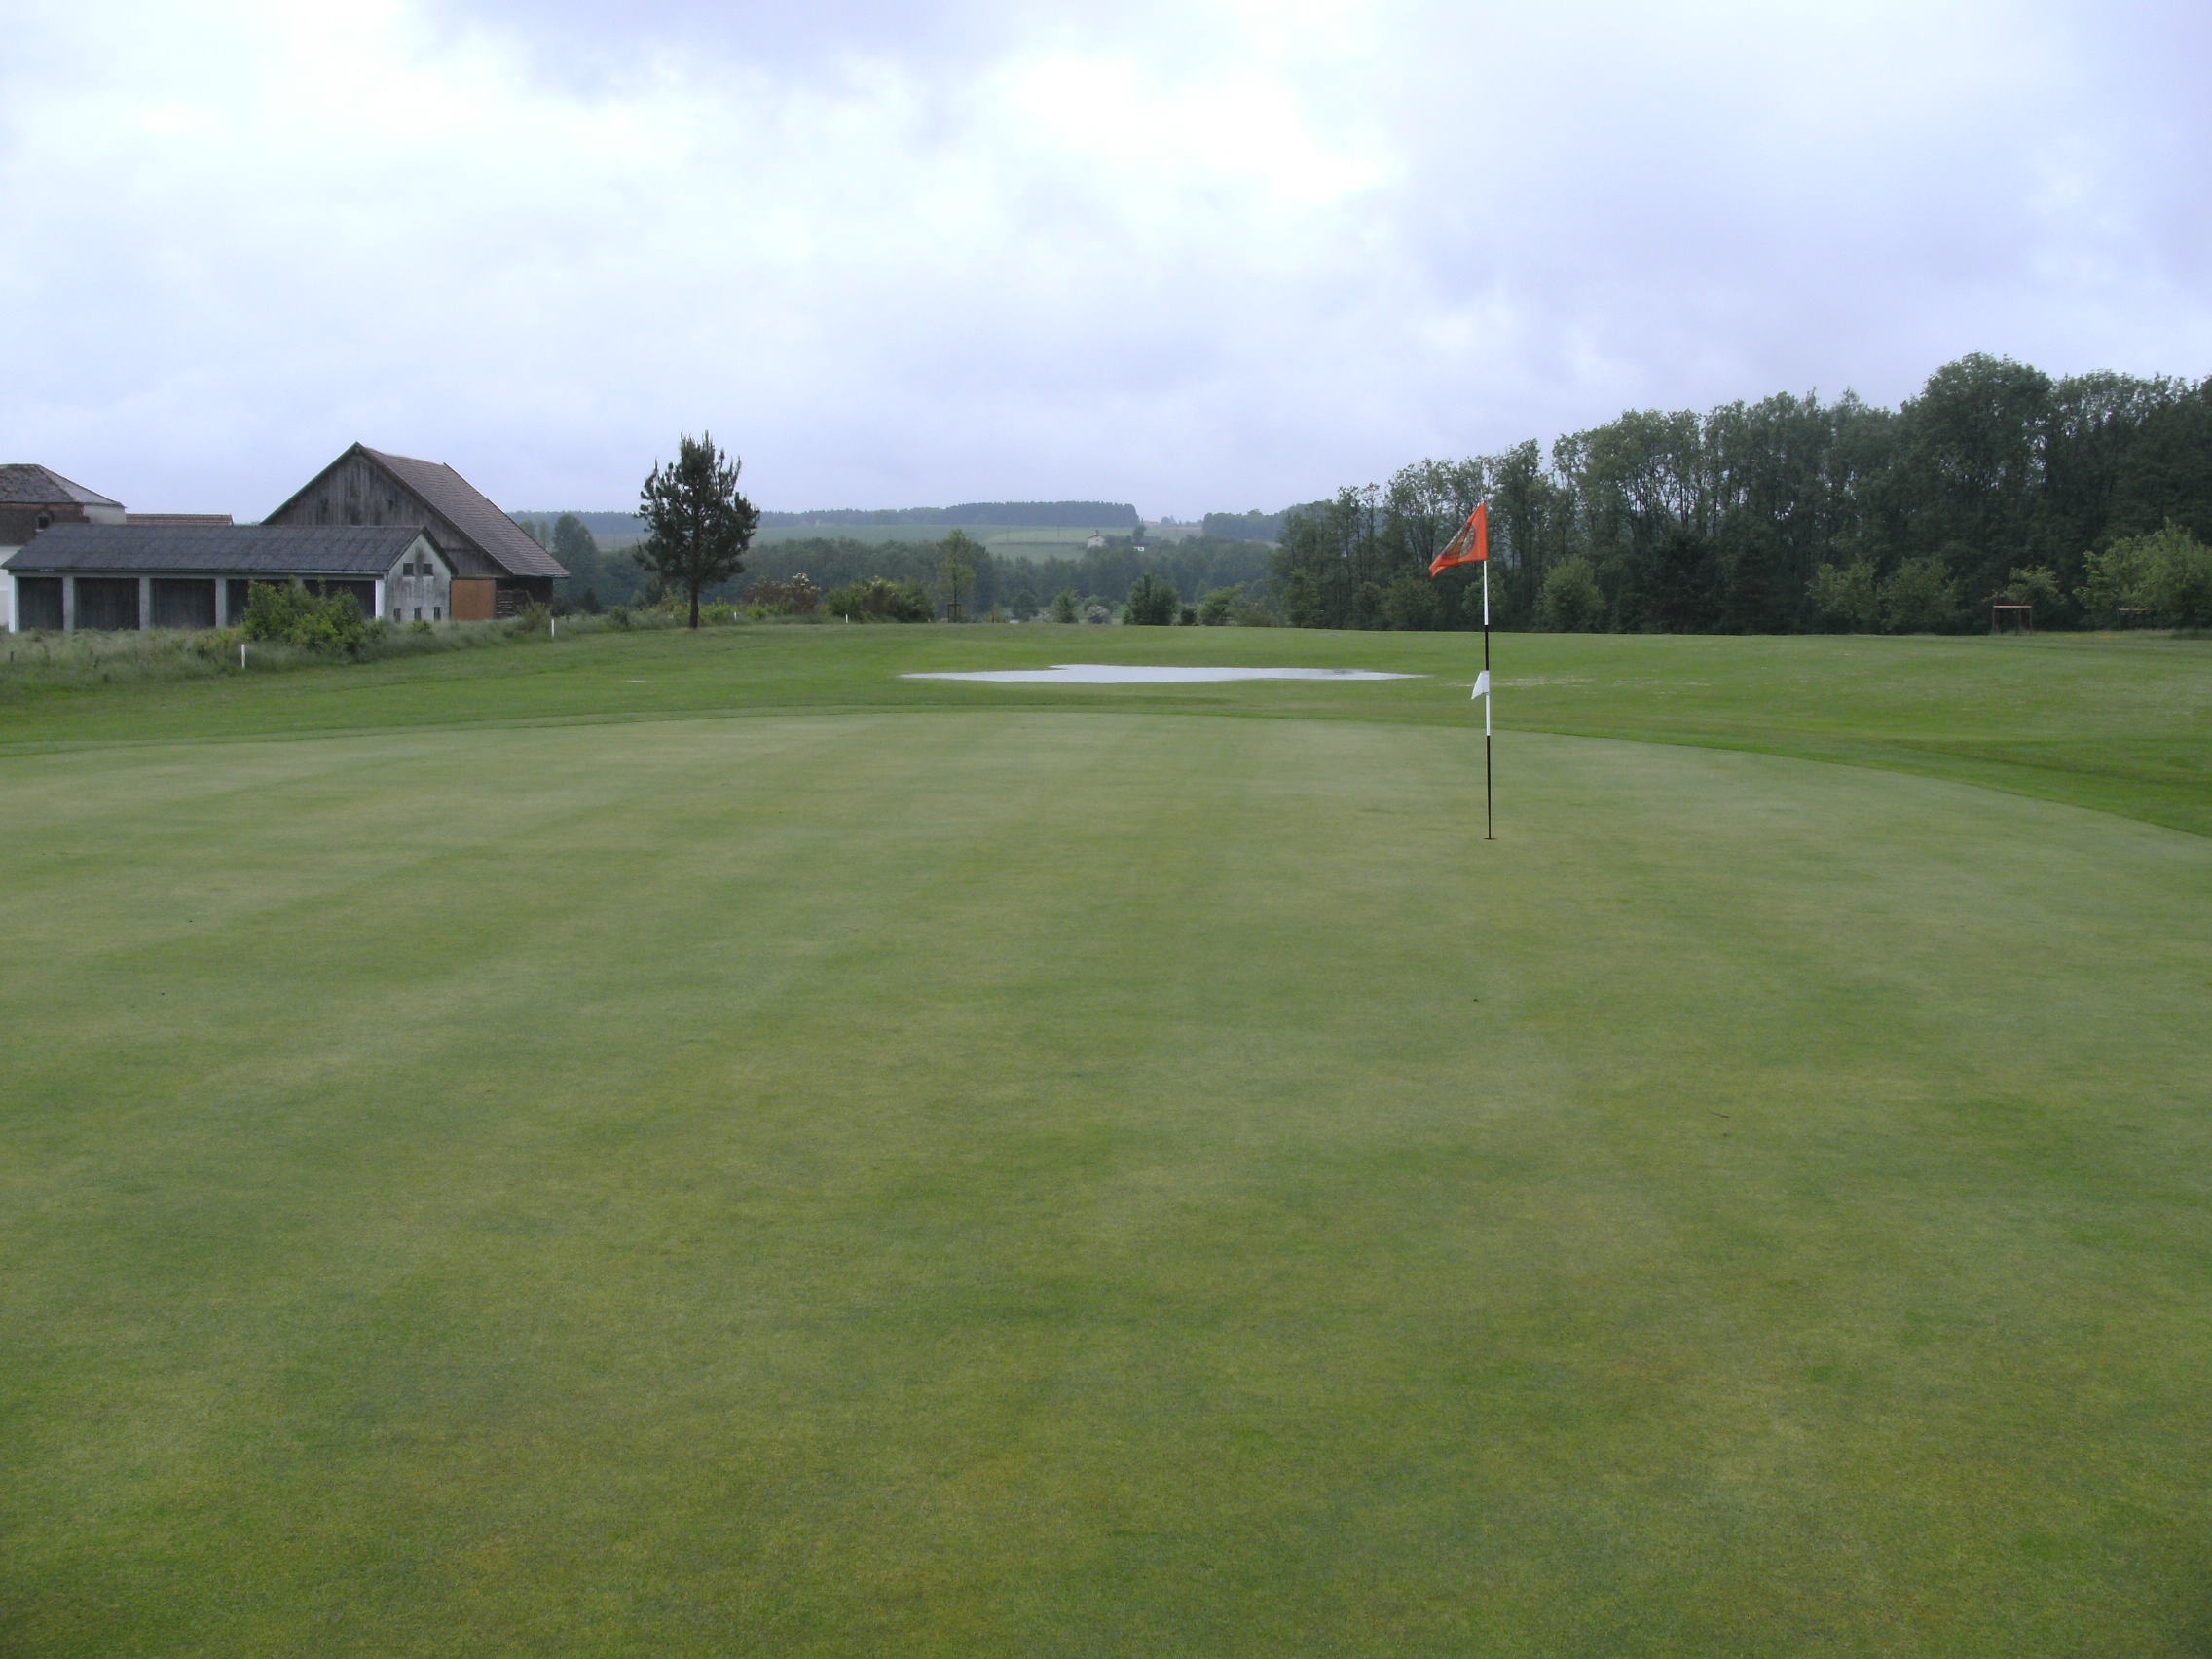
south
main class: Grassland
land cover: Grassland without tree/shrub cover
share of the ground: > 75 %
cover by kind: herbaceous plants 100 %
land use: Sport
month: May
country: AT
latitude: 48.3834
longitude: 13.5237
